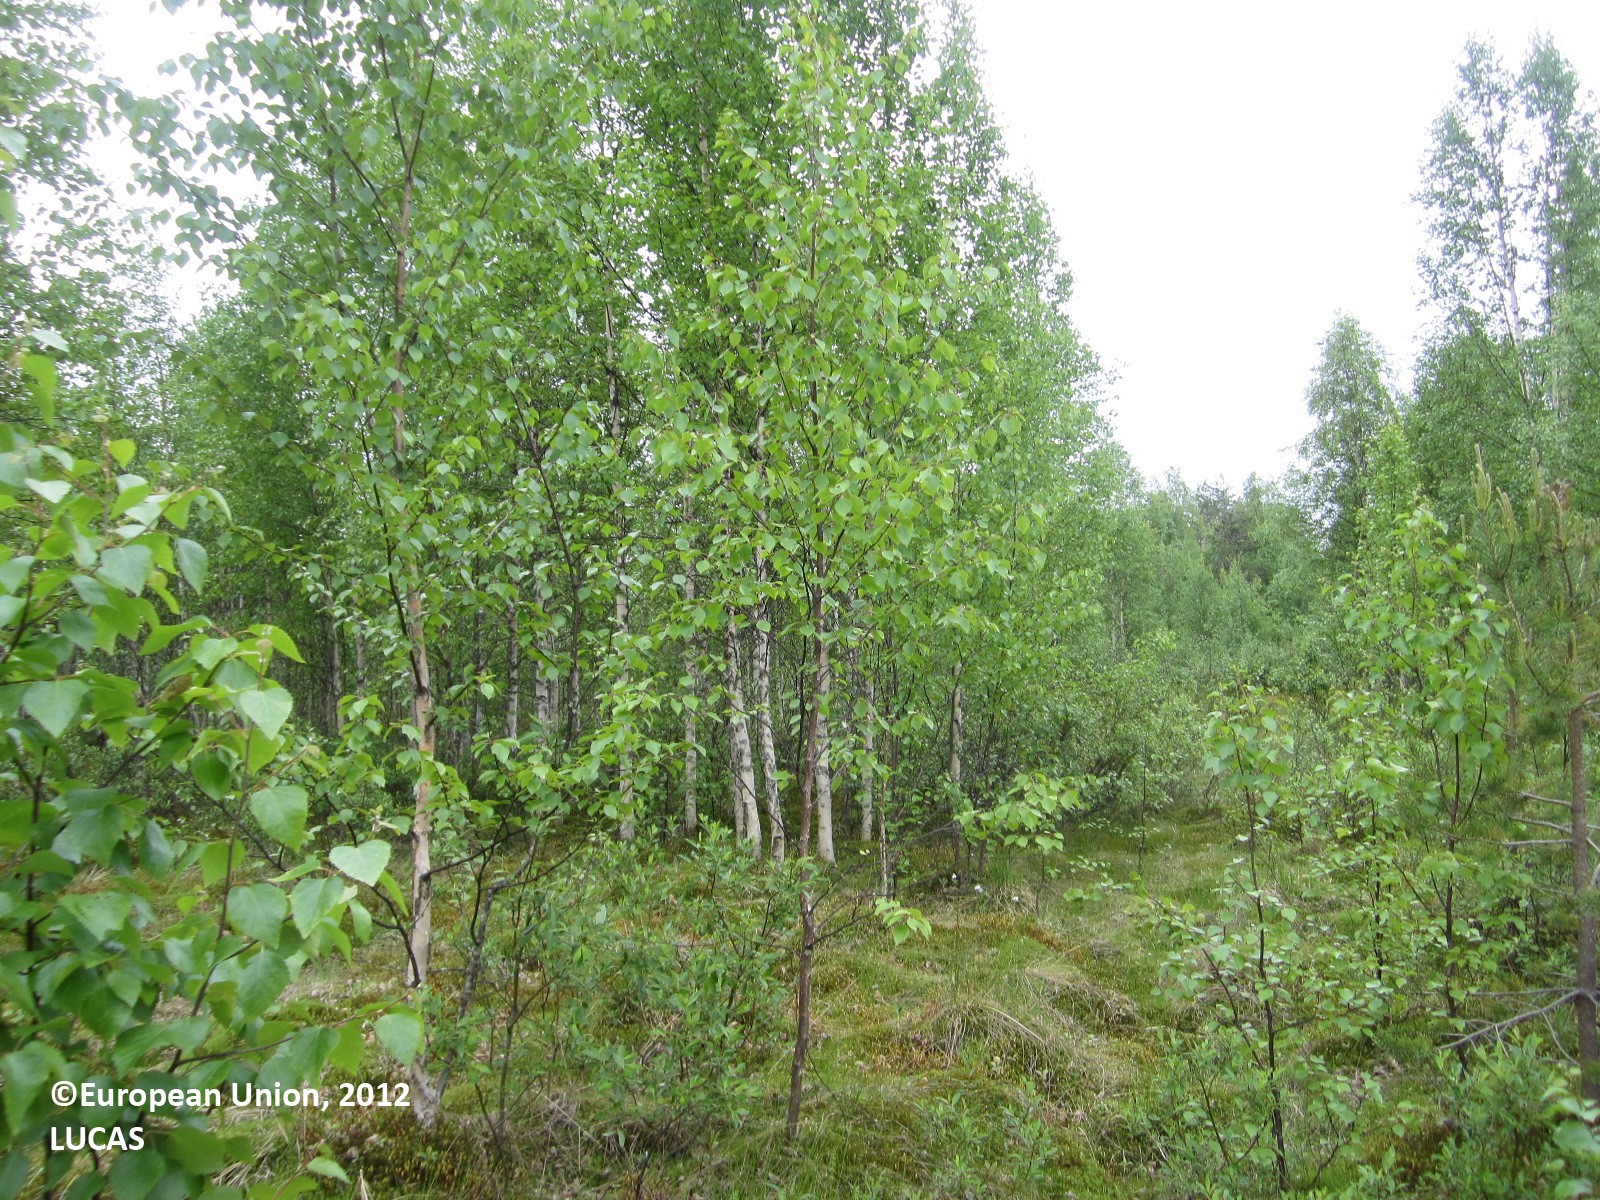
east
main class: Woodland
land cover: Broadleaved woodland
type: boreal forest
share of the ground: 50 - 75 %
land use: Forestry
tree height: > 5 m
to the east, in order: Broadleaved woodland; Spontaneously vegetated surfaces; Broadleaved woodland; Pine dominated mixed woodland; Ditches and canals; Pine dominated mixed woodland
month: June
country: FI
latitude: 64.7212
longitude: 29.6733
